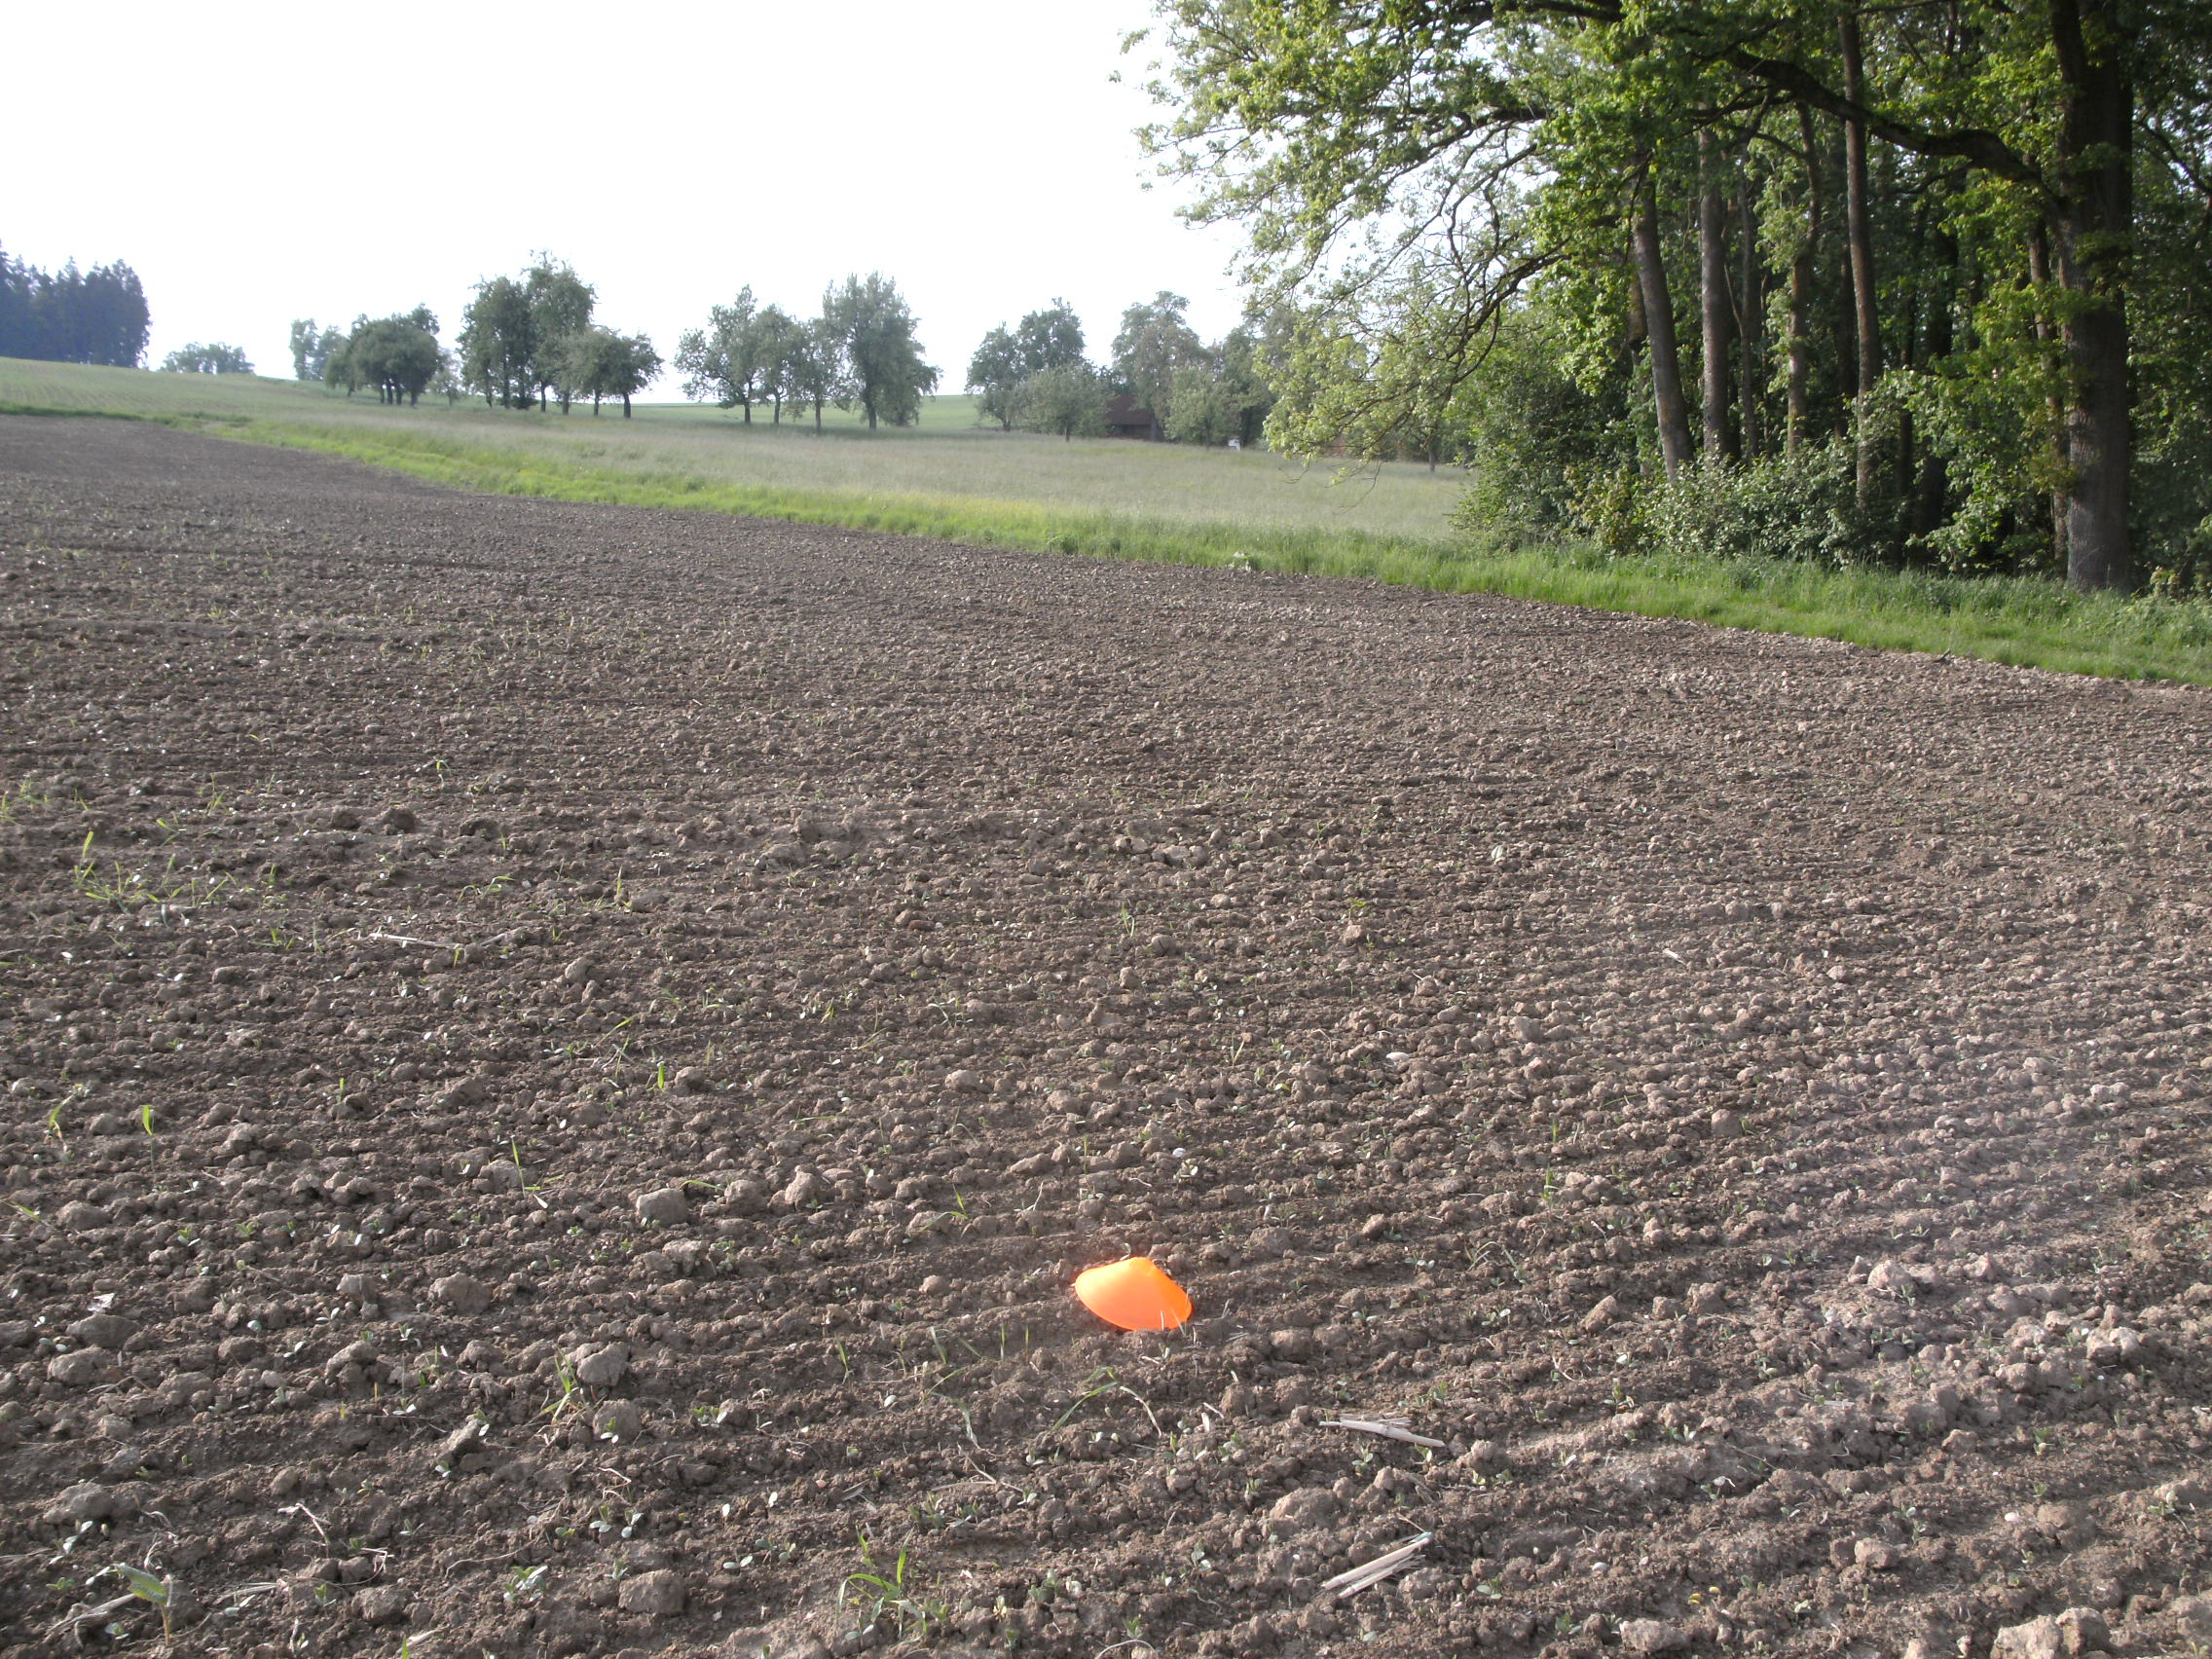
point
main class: Cropland
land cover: Soya
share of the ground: < 10 %
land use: Agriculture (excluding fallow land and kitchen gardens)
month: May
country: AT
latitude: 48.3583
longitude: 13.7380
